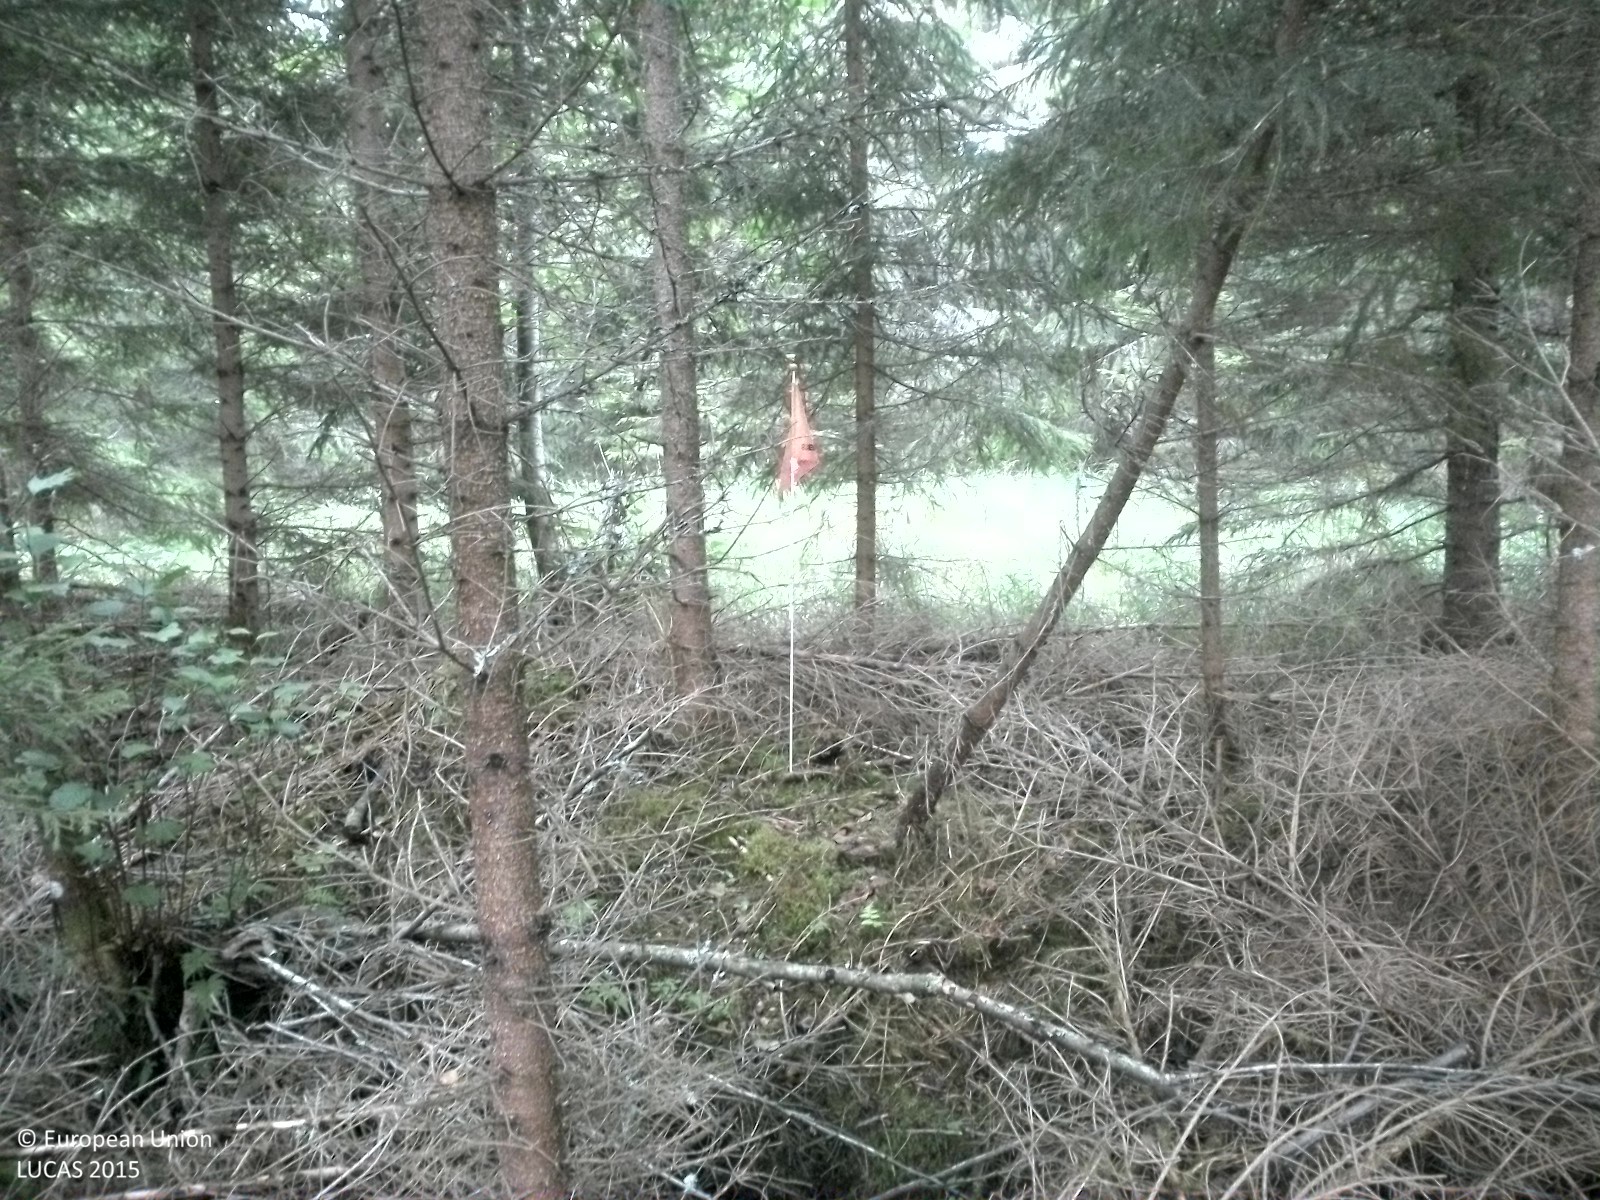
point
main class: Woodland
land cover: Spruce dominated coniferous woodland
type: boreal forest
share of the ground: 50 - 75 %
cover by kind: coniferous forest trees 70 %, lichens and mosses 20 %, broadleaved forest trees 5 %, herbaceous plants 5 %
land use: Forestry
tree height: < 5 m
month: August
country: SE
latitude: 59.0097
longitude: 15.4775
